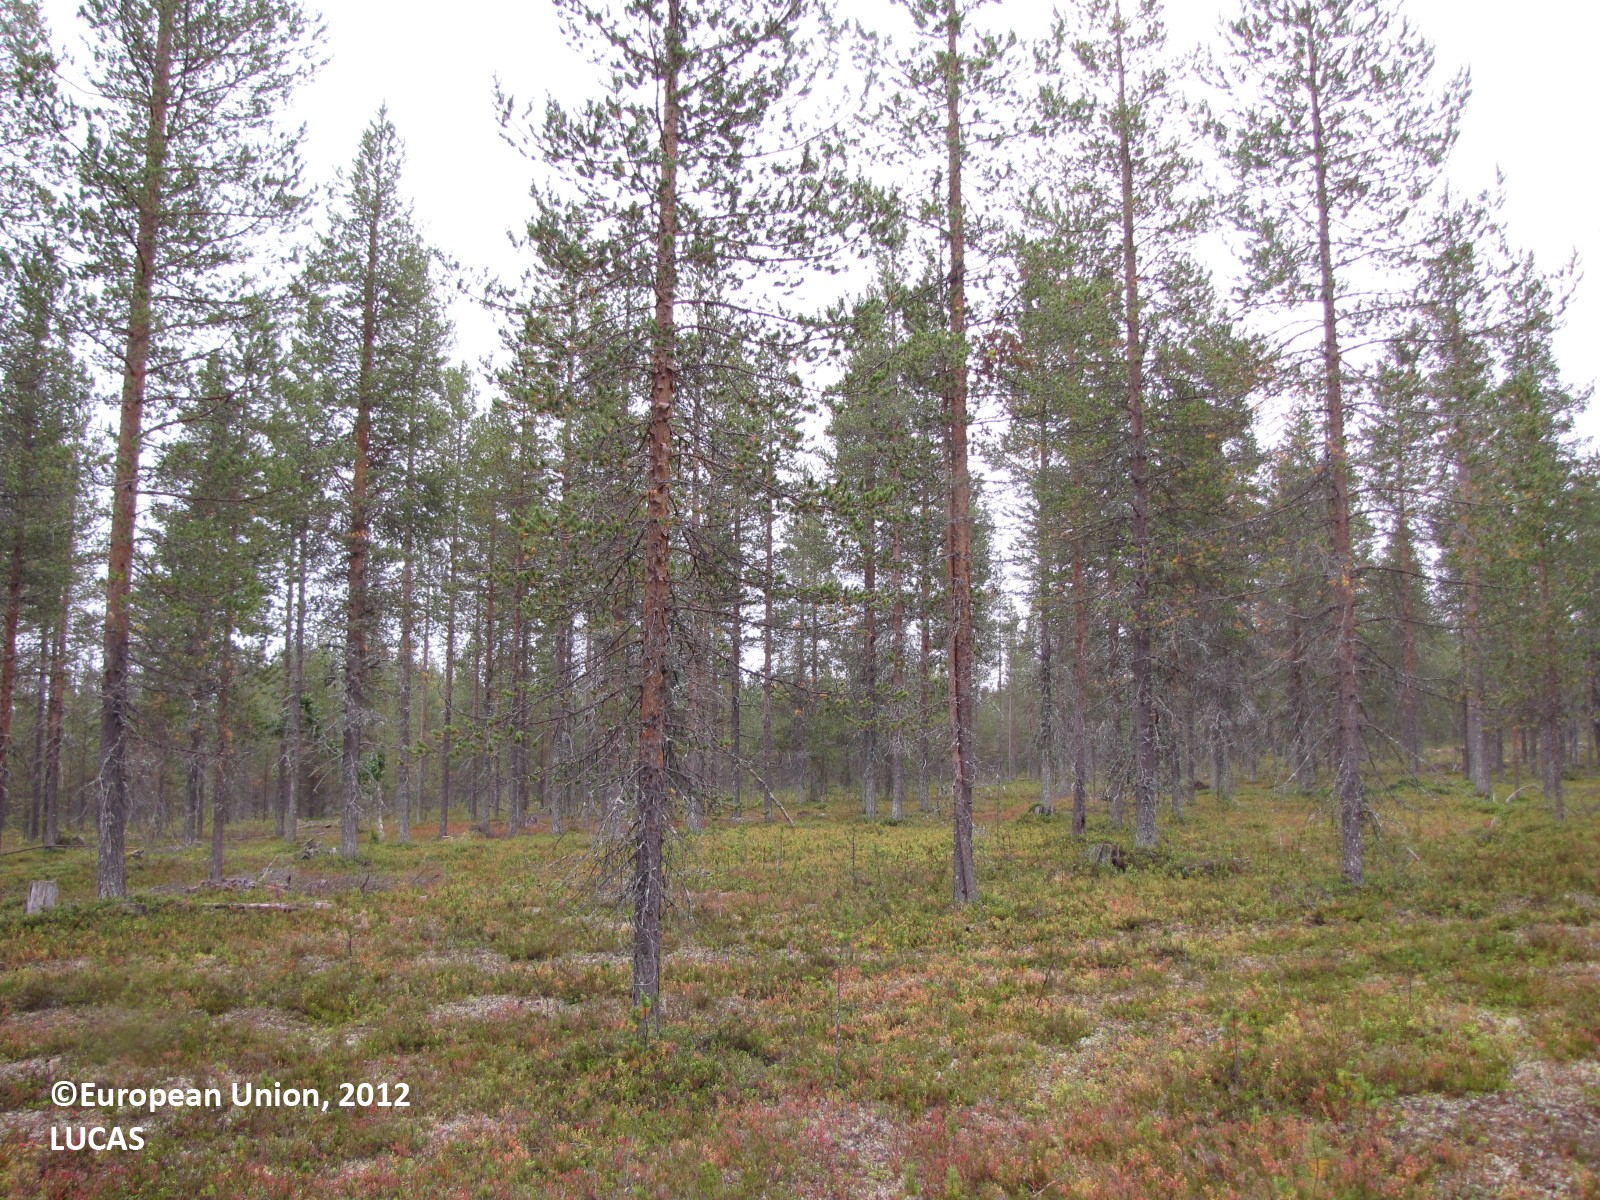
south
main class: Woodland
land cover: Pine dominated coniferous woodland
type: boreal forest
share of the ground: 25 - 50 %
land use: Forestry
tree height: > 5 m
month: August
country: FI
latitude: 67.0988
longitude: 24.8027
